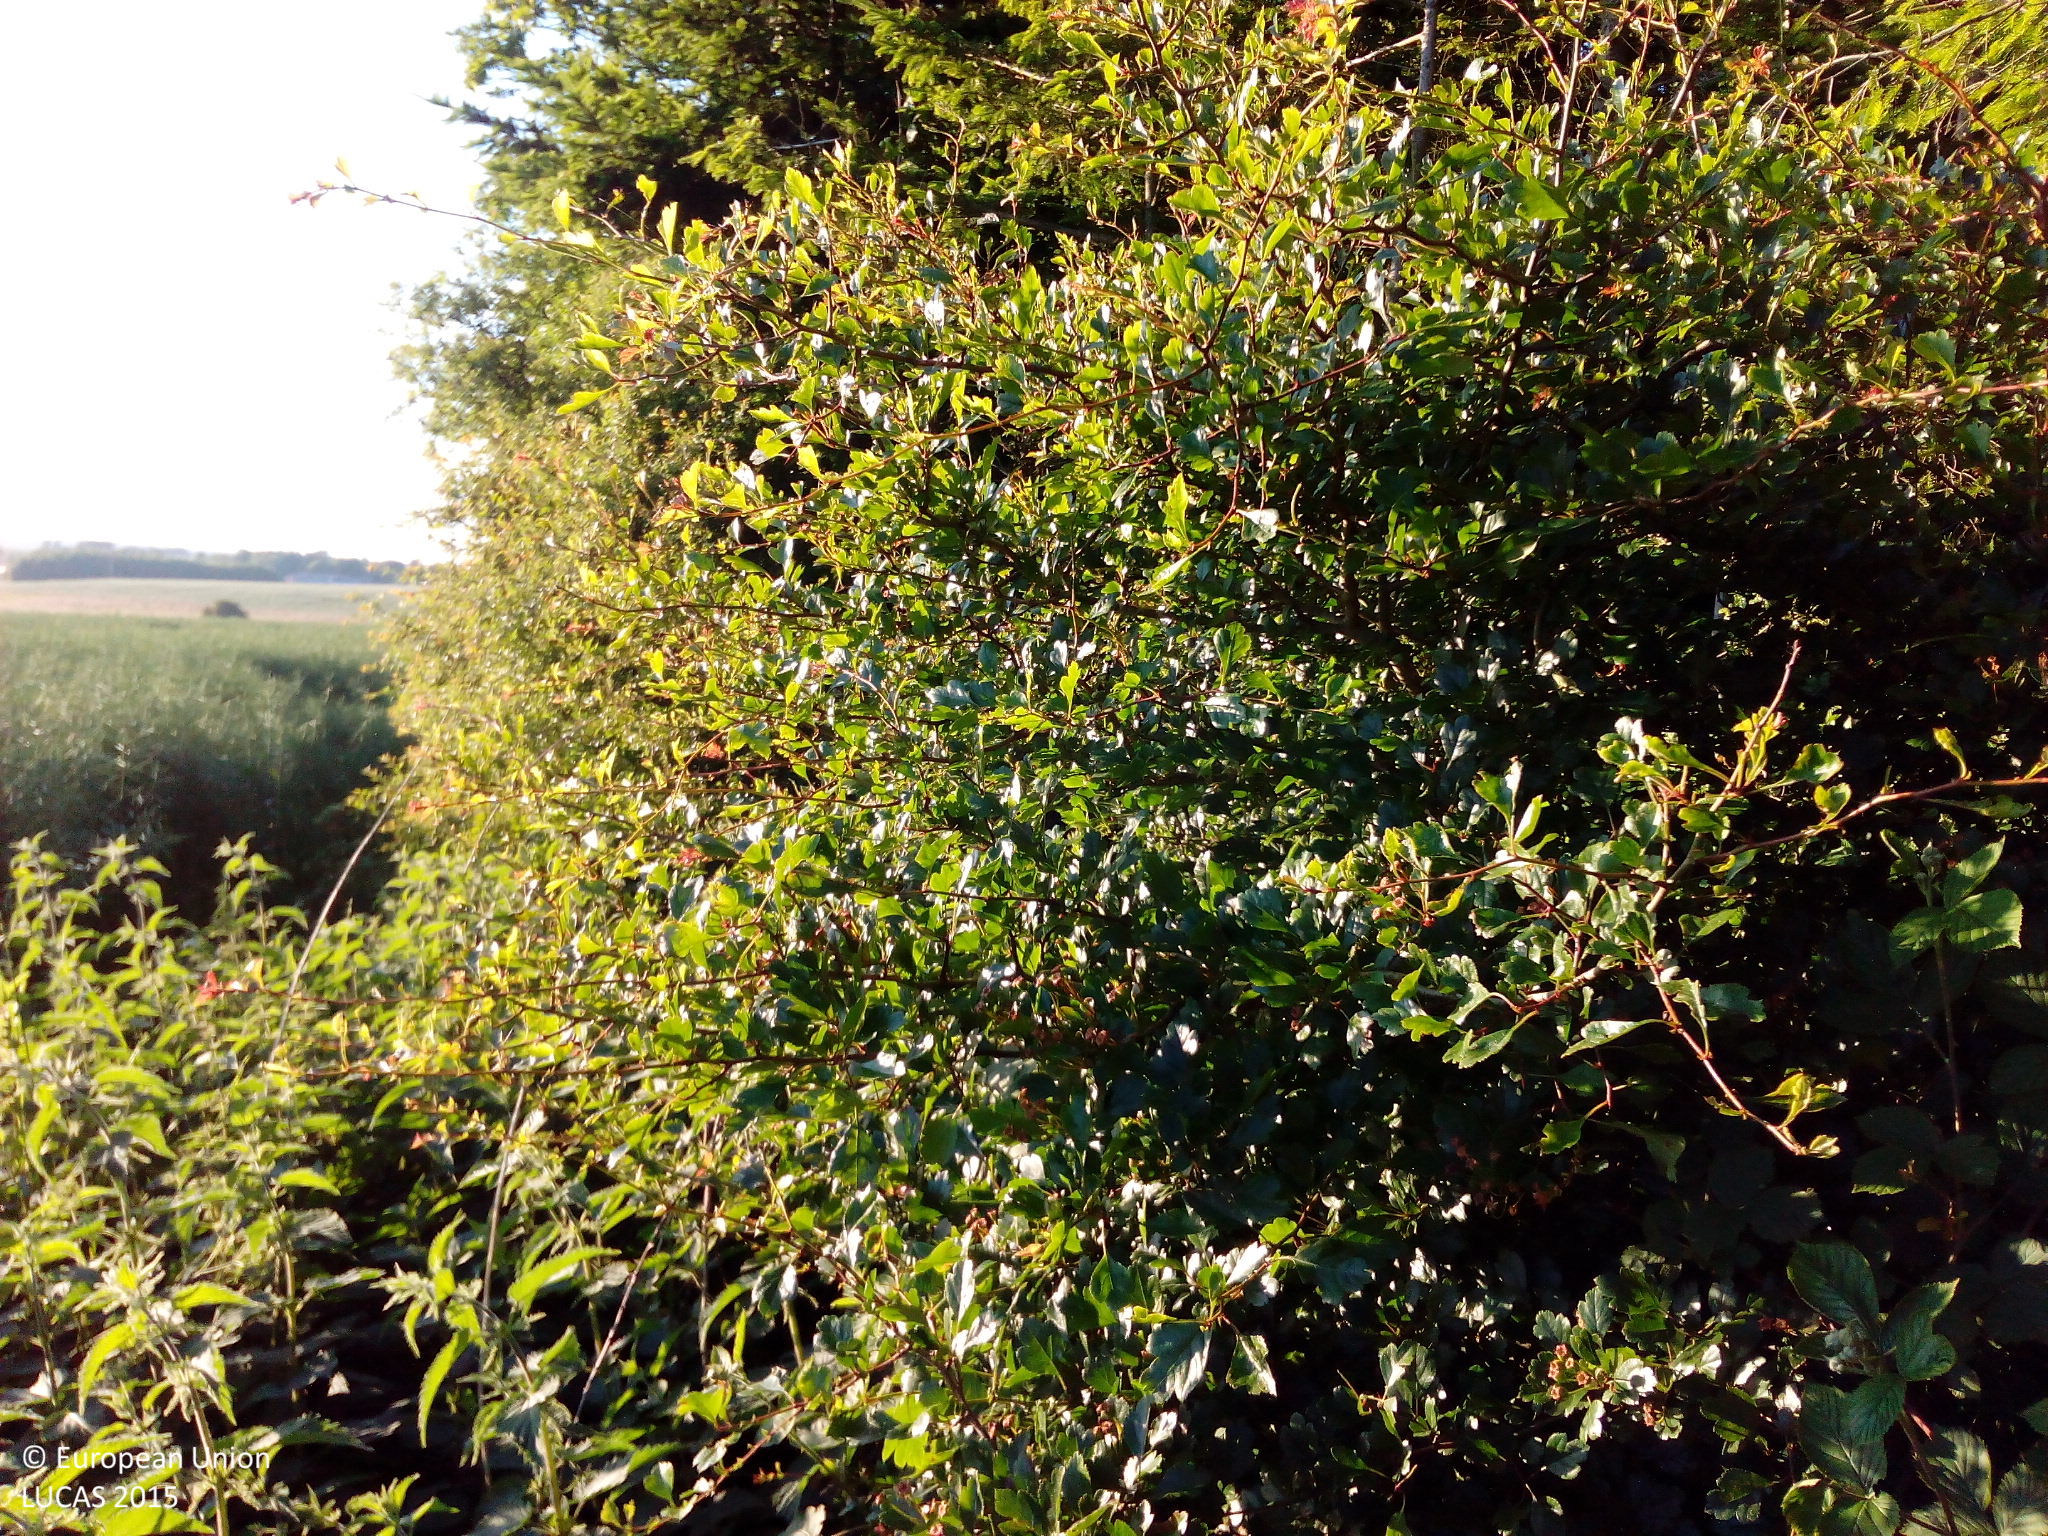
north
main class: Cropland
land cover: Rape and turnip rape
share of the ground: > 75 %
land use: Agriculture (excluding fallow land and kitchen gardens)
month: June
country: DK
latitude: 56.3651
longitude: 10.7922
